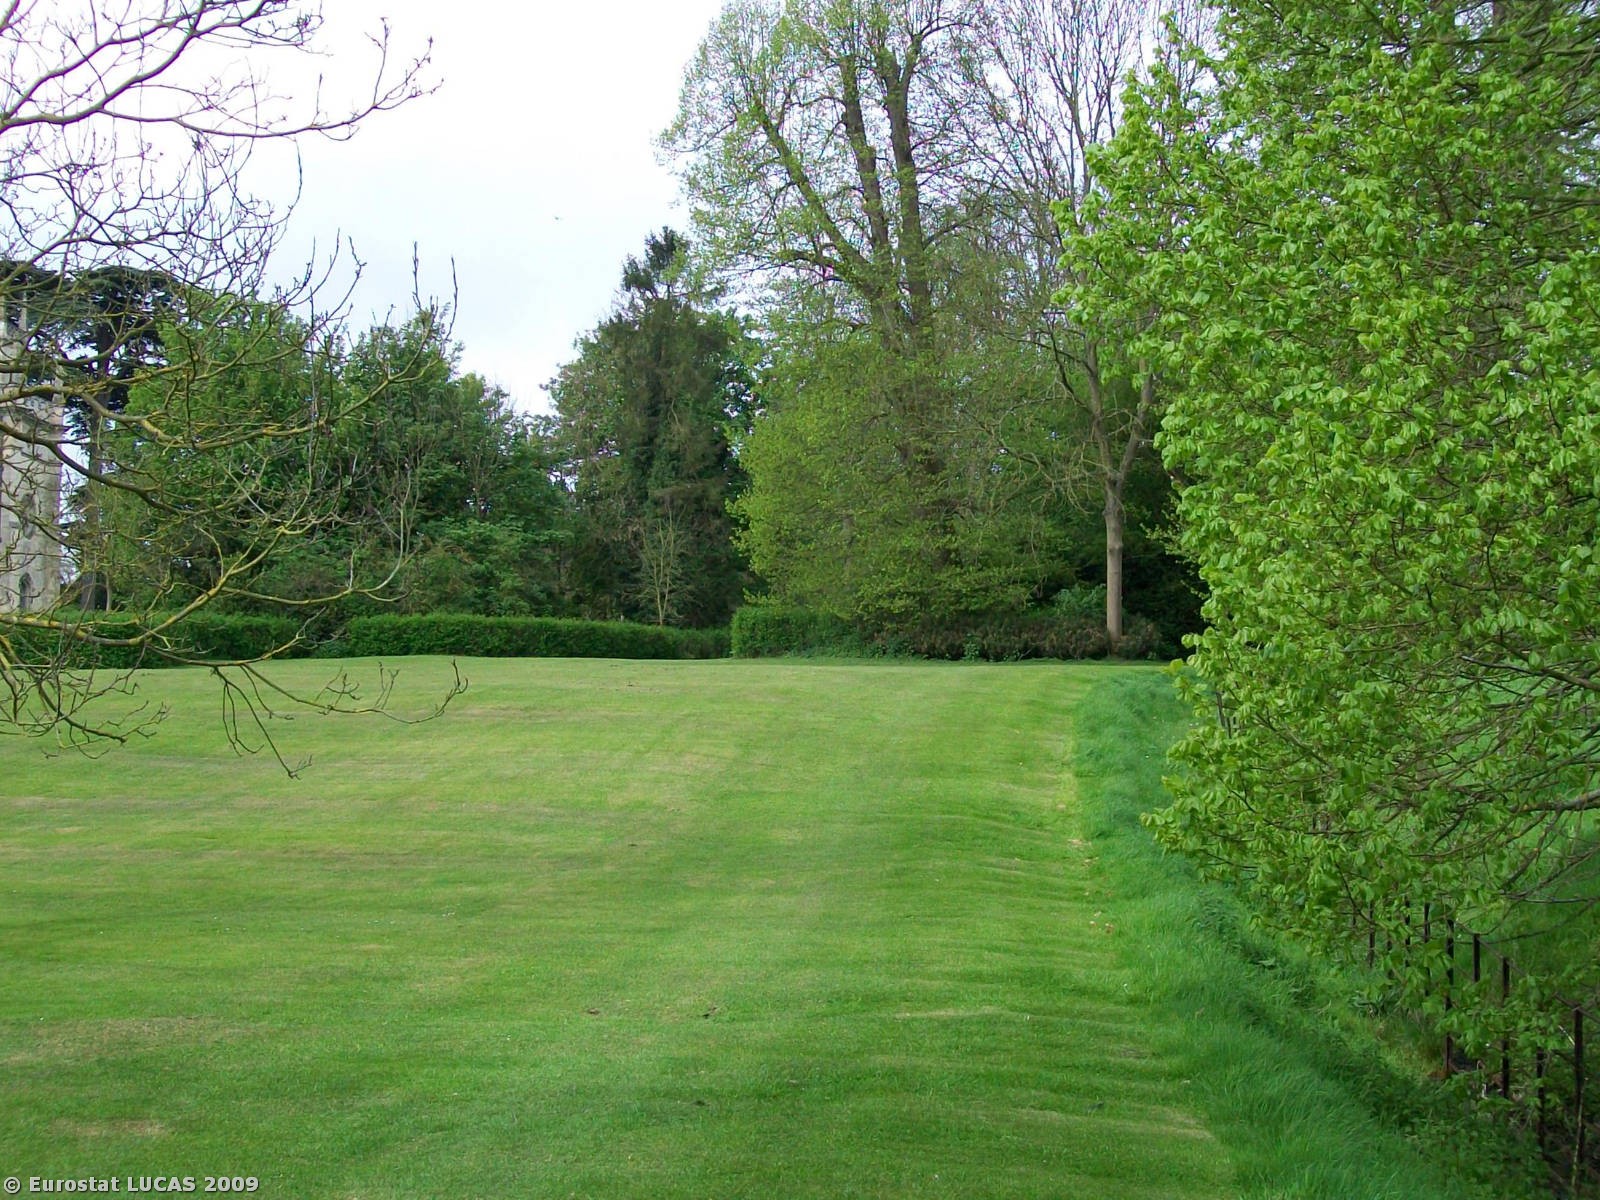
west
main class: Grassland
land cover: Grassland without tree/shrub cover
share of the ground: > 75 %
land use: Agriculture (excluding fallow land and kitchen gardens)
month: April
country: GB
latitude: 51.8062
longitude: -0.8474
